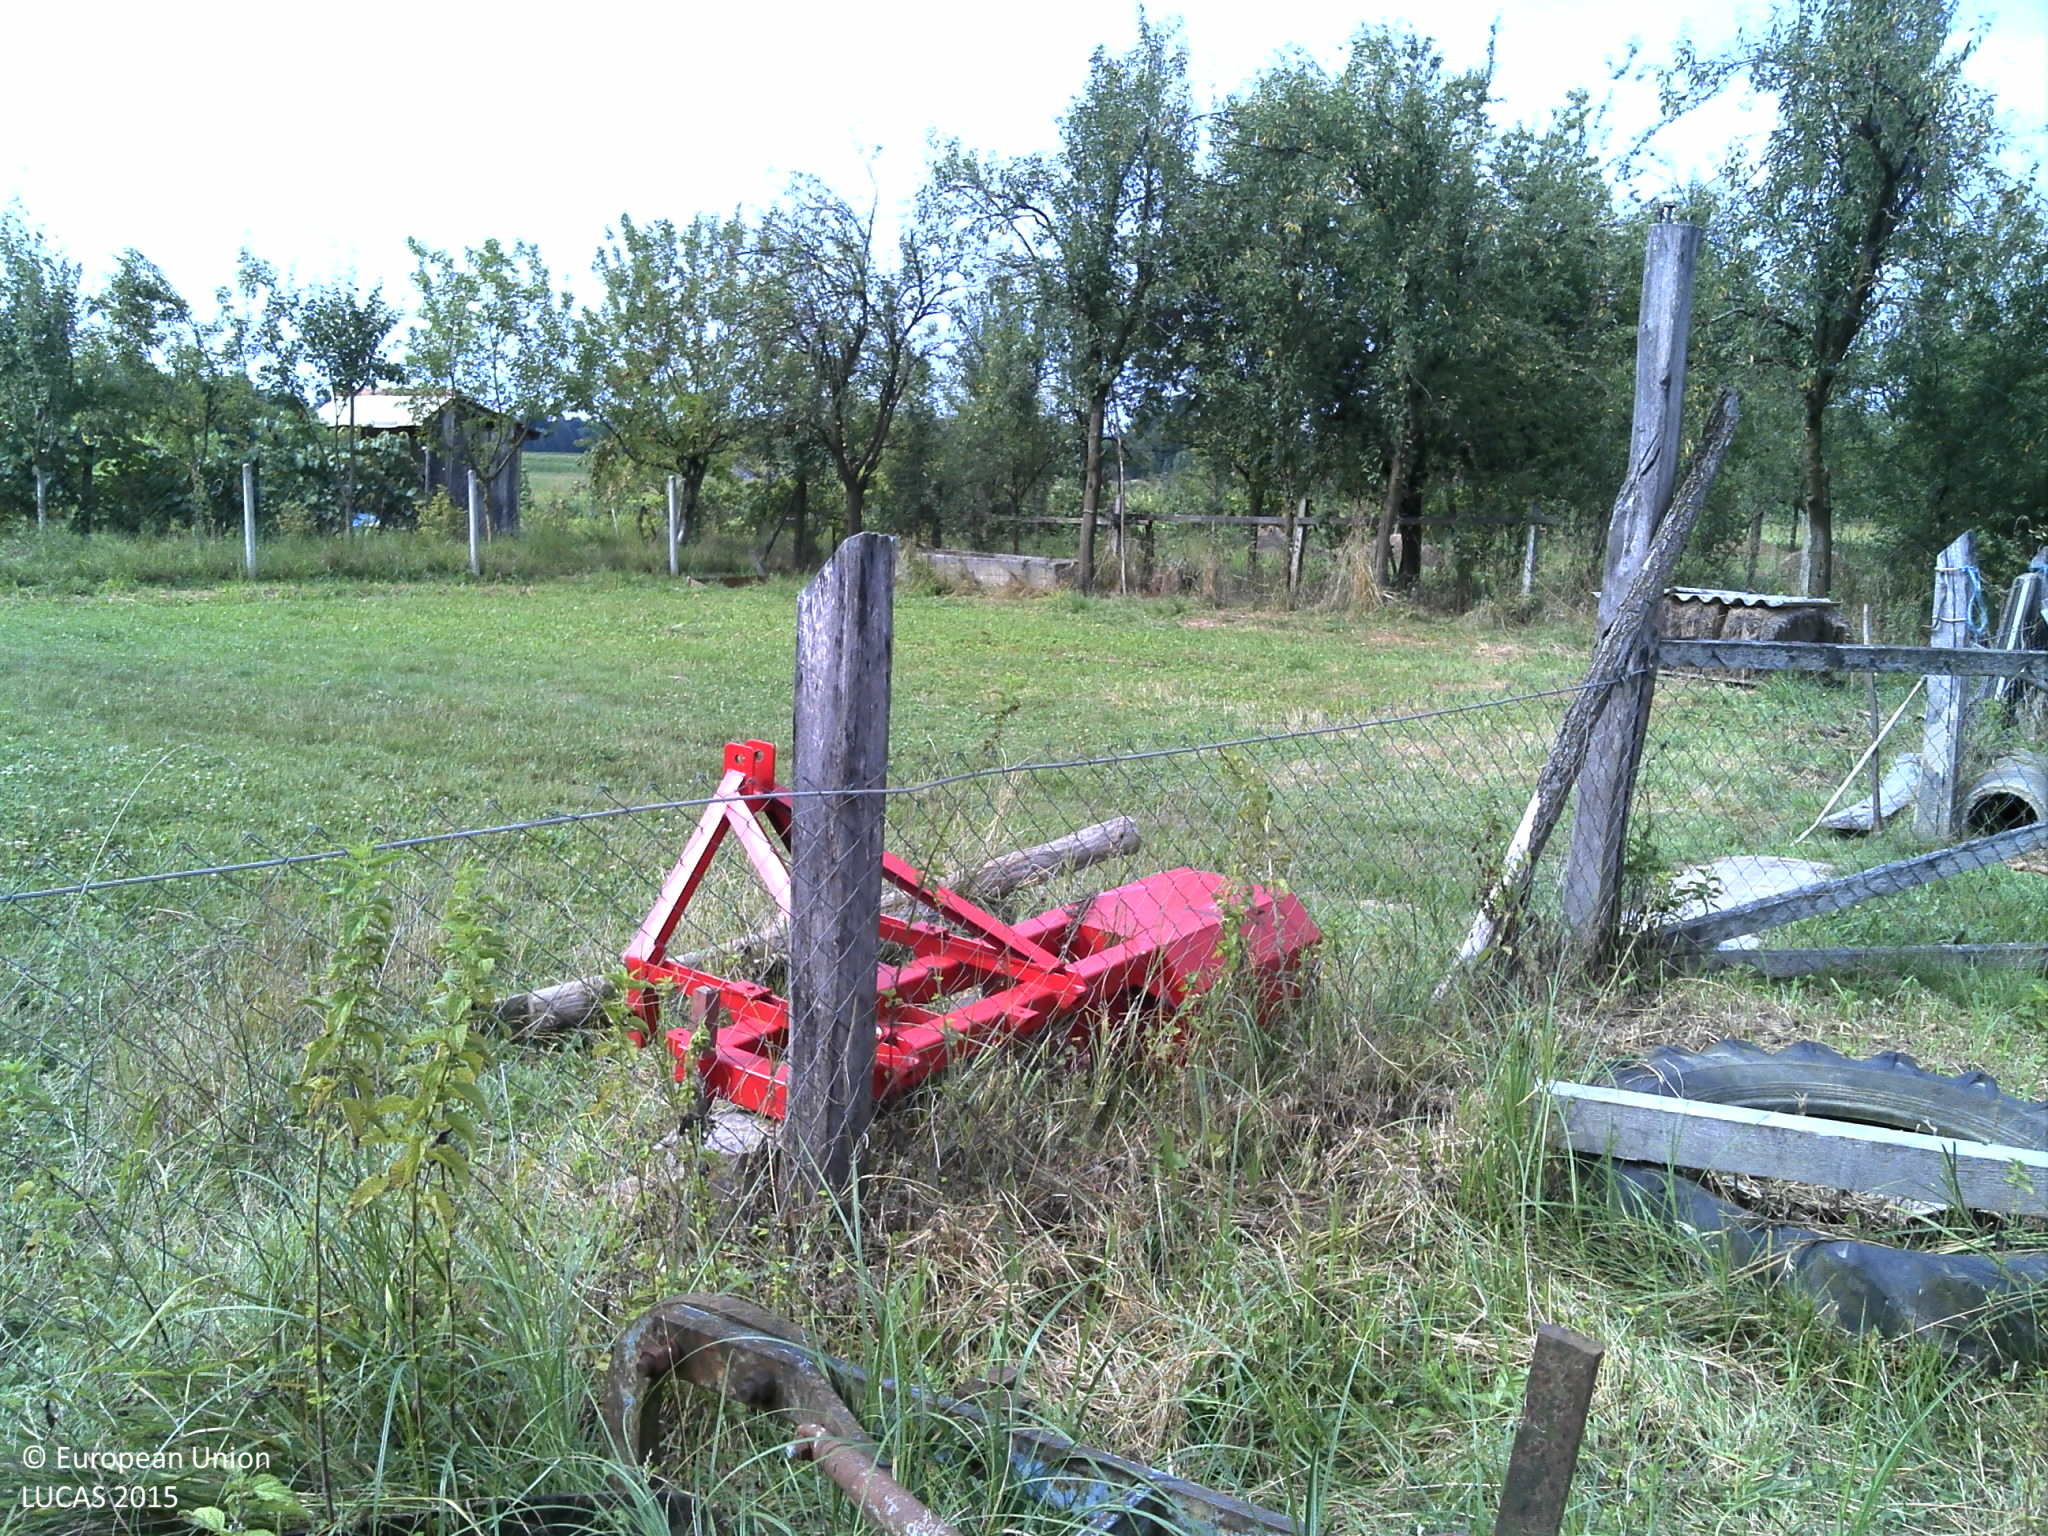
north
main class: Grassland
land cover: Spontaneously vegetated surfaces
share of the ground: > 75 %
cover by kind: herbaceous plants 100 %
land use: Fallow land
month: July
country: HR
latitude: 45.6511
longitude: 17.2769
